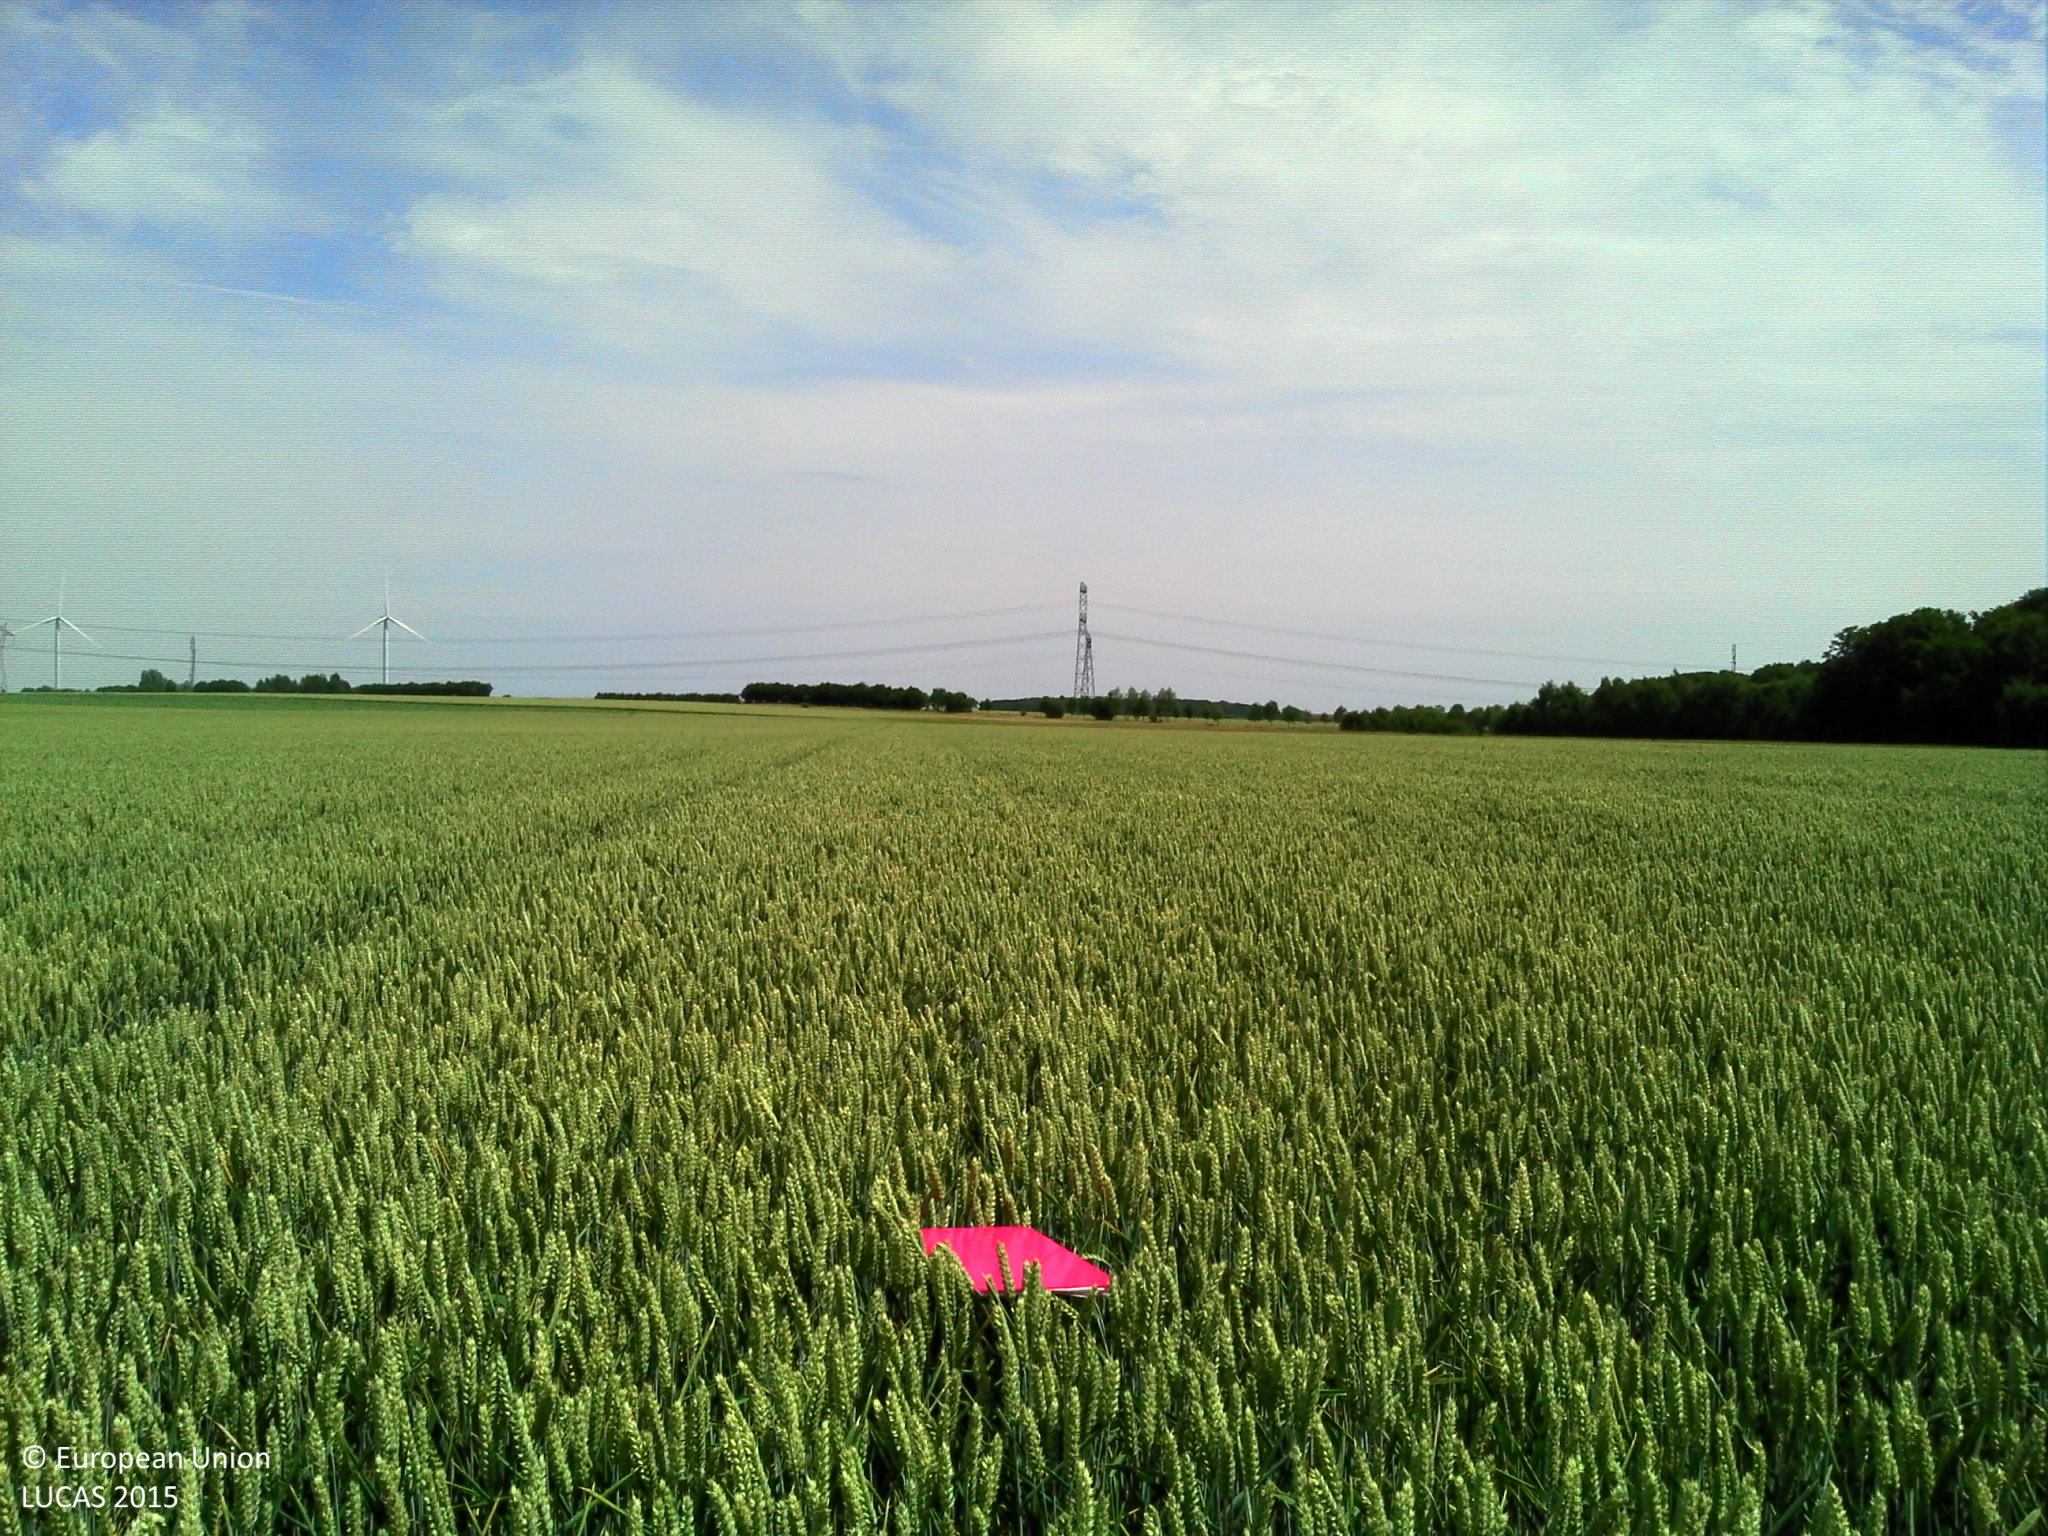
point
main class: Cropland
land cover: Common wheat
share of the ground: > 75 %
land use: Agriculture (excluding fallow land and kitchen gardens)
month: June
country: FR
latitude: 49.6827
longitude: 2.2108
